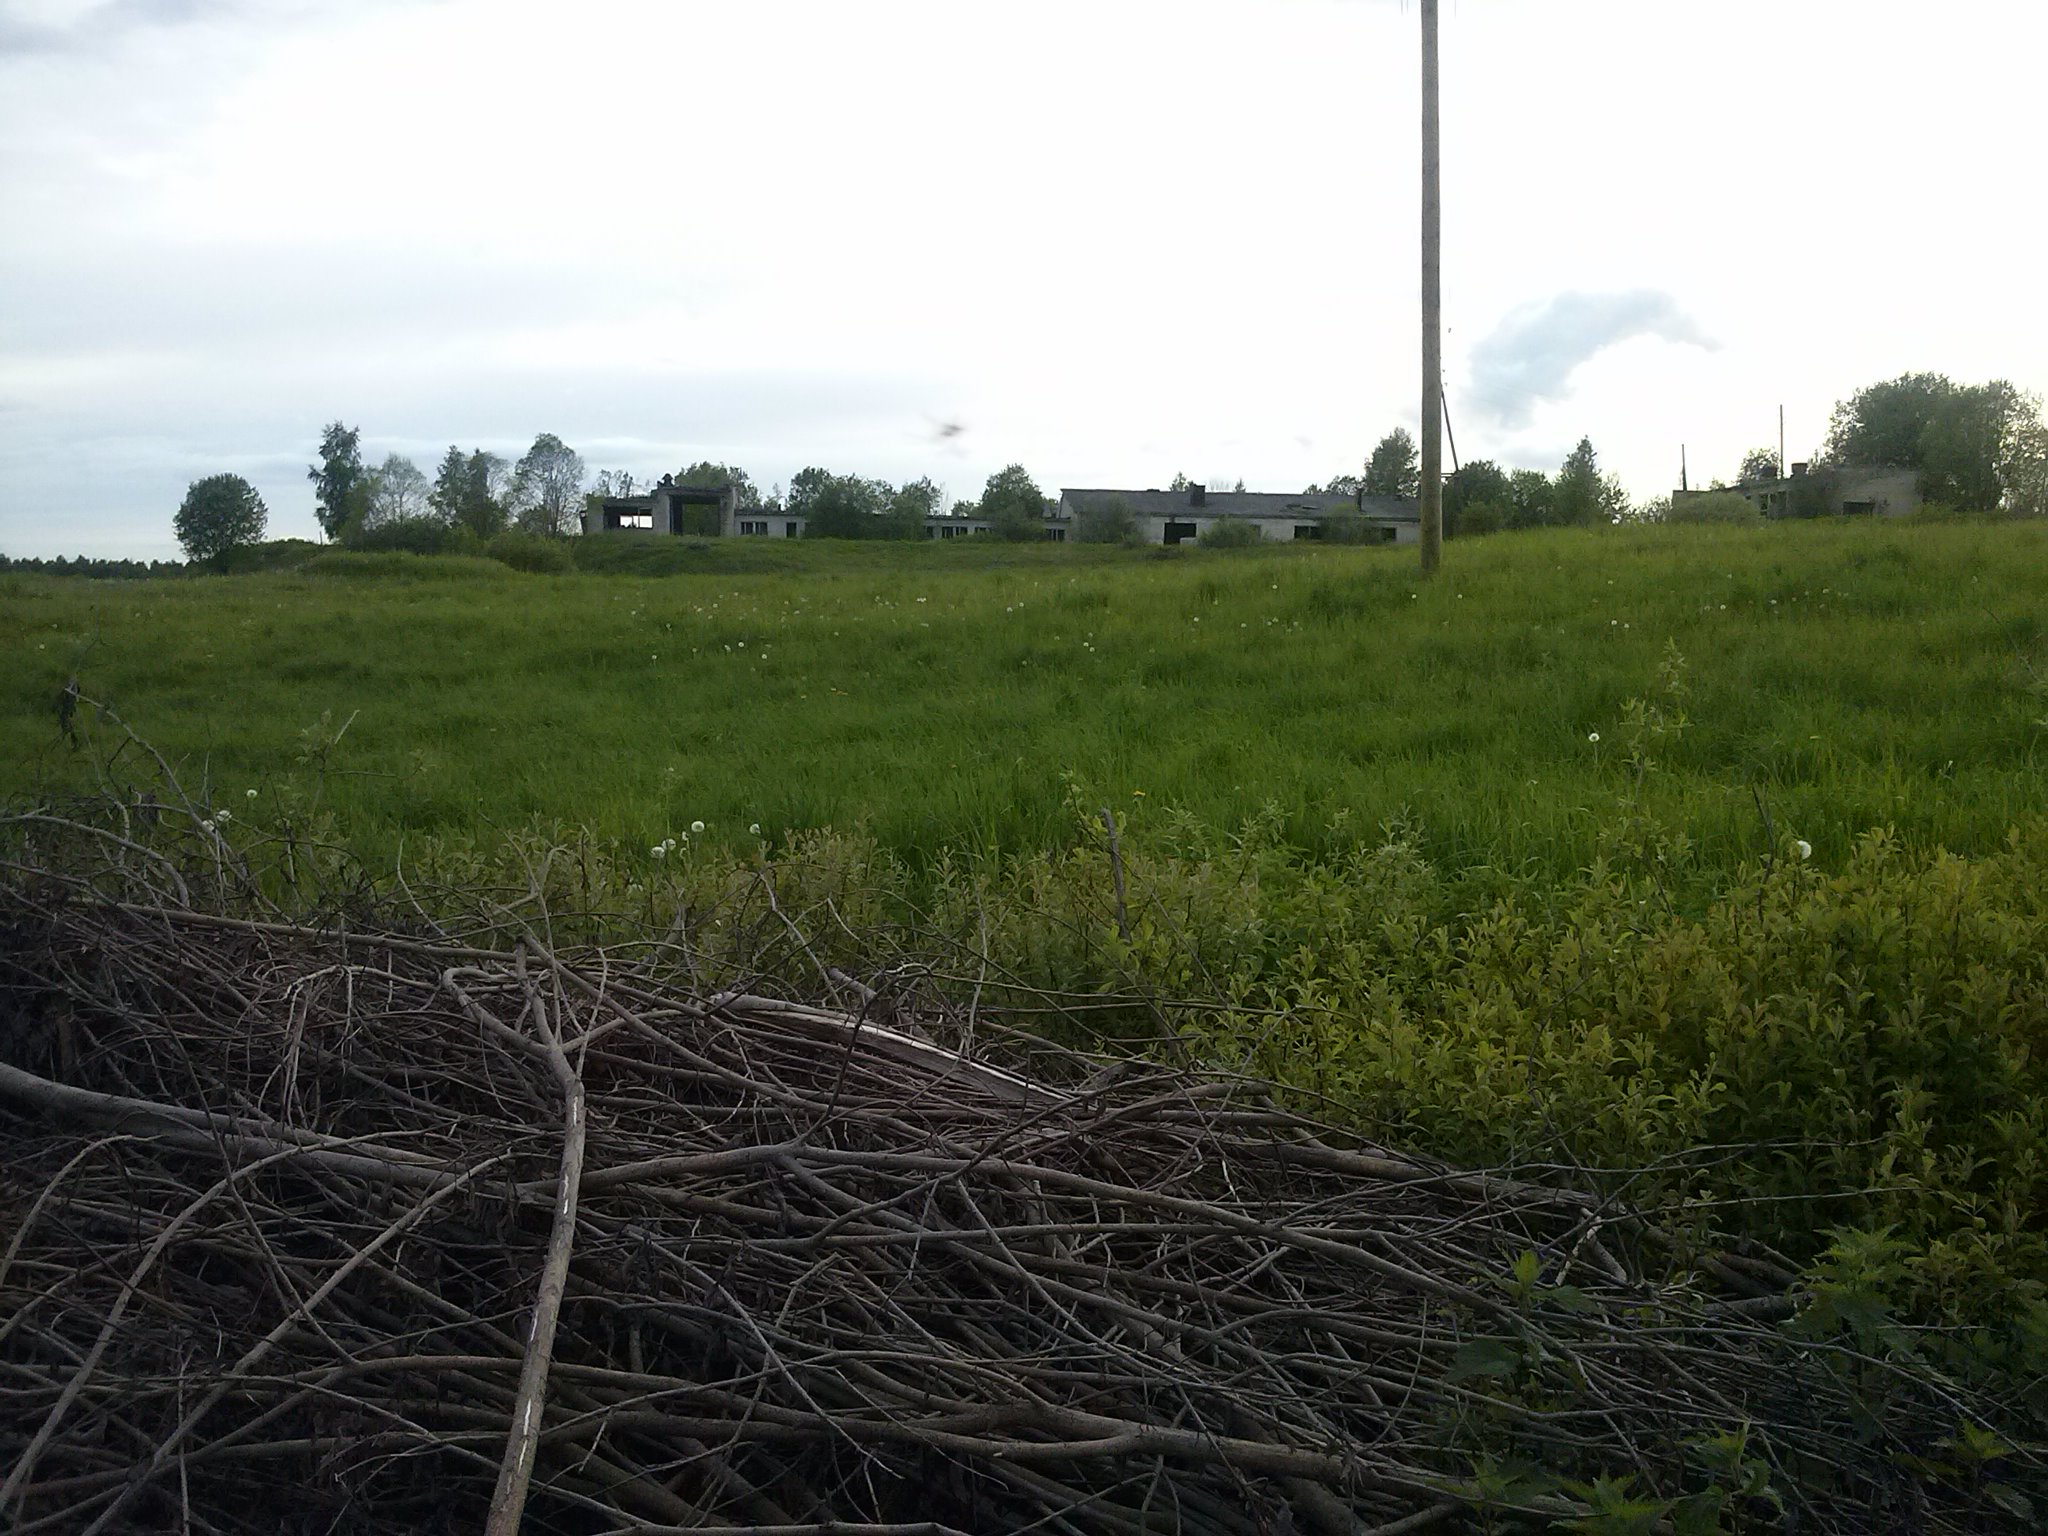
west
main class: Grassland
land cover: Grassland without tree/shrub cover
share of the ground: > 75 %
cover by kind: herbaceous plants 100 %
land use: Agriculture (excluding fallow land and kitchen gardens)
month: May
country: LV
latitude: 56.2746
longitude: 27.8101
